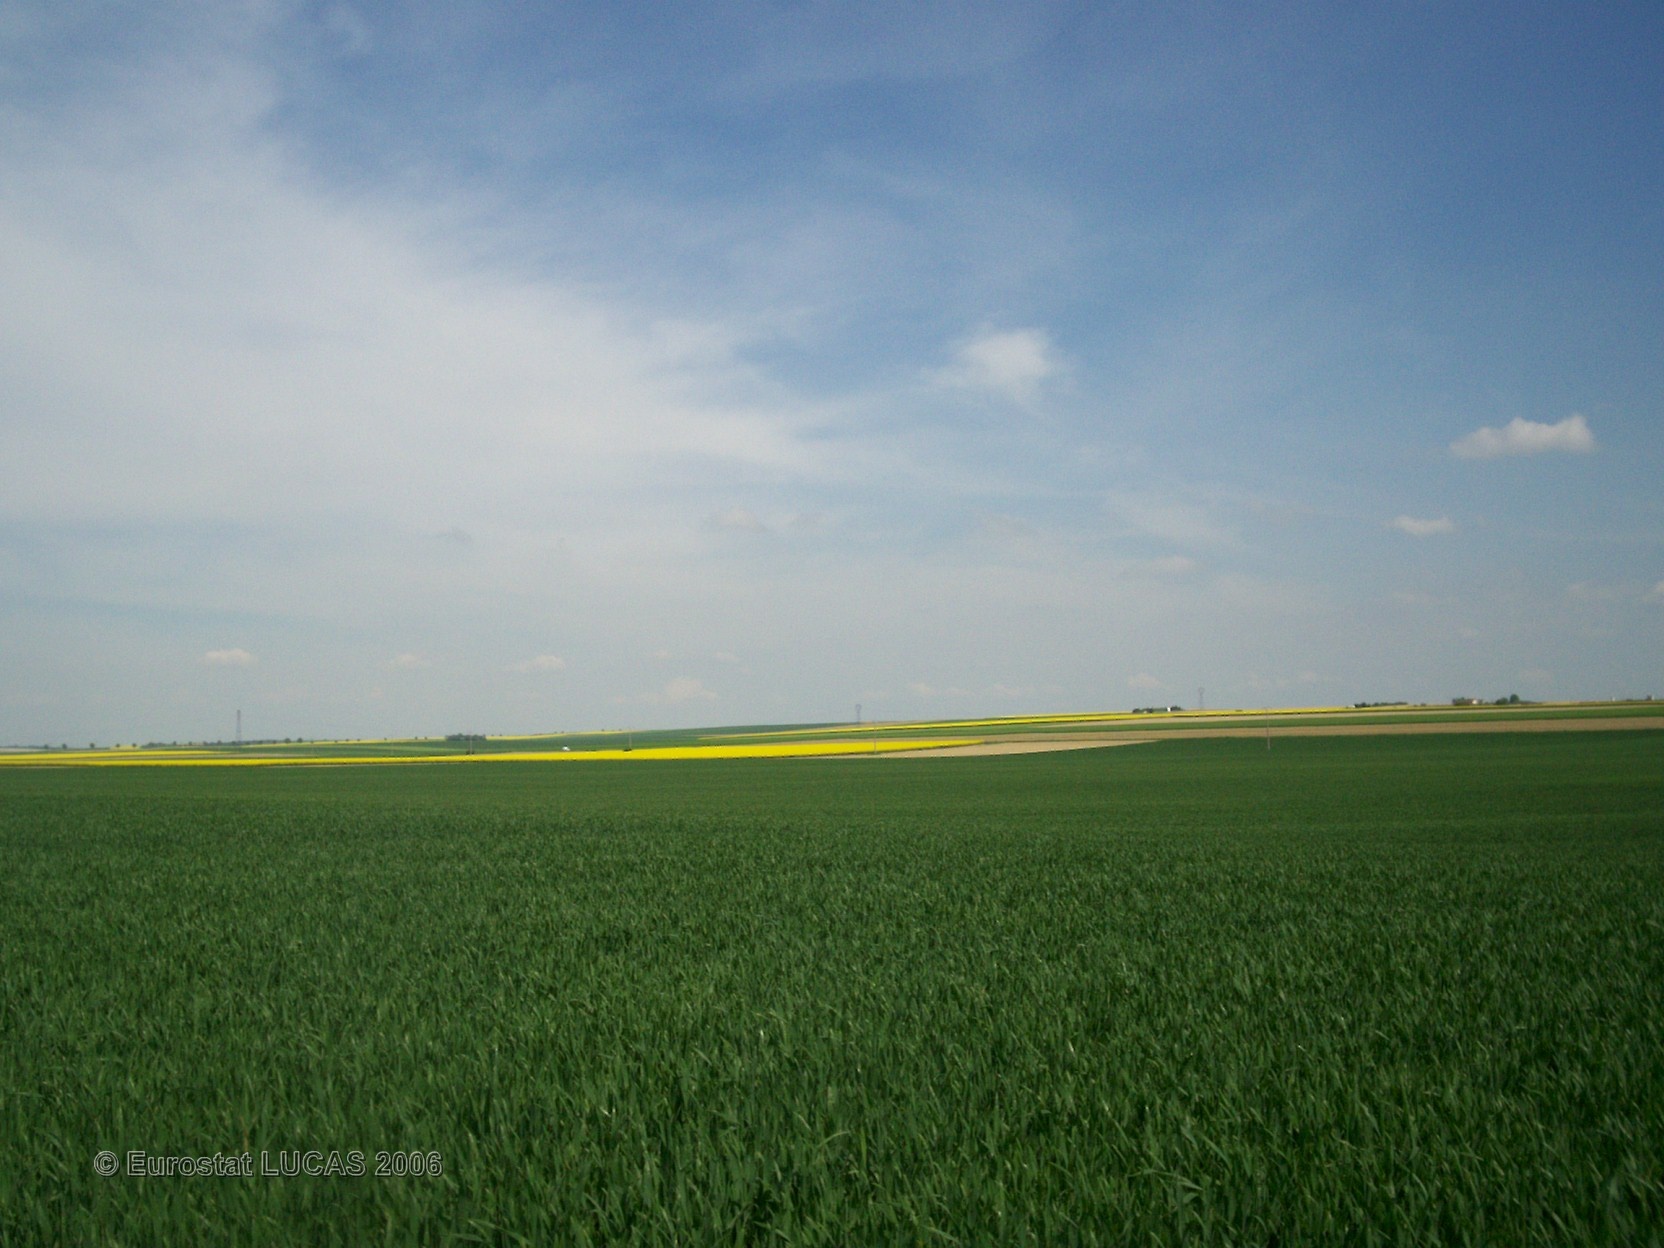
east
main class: Cropland
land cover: Common wheat
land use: Agriculture (excluding fallow land and kitchen gardens)
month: May
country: FR
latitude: 48.9130
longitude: 4.4431
